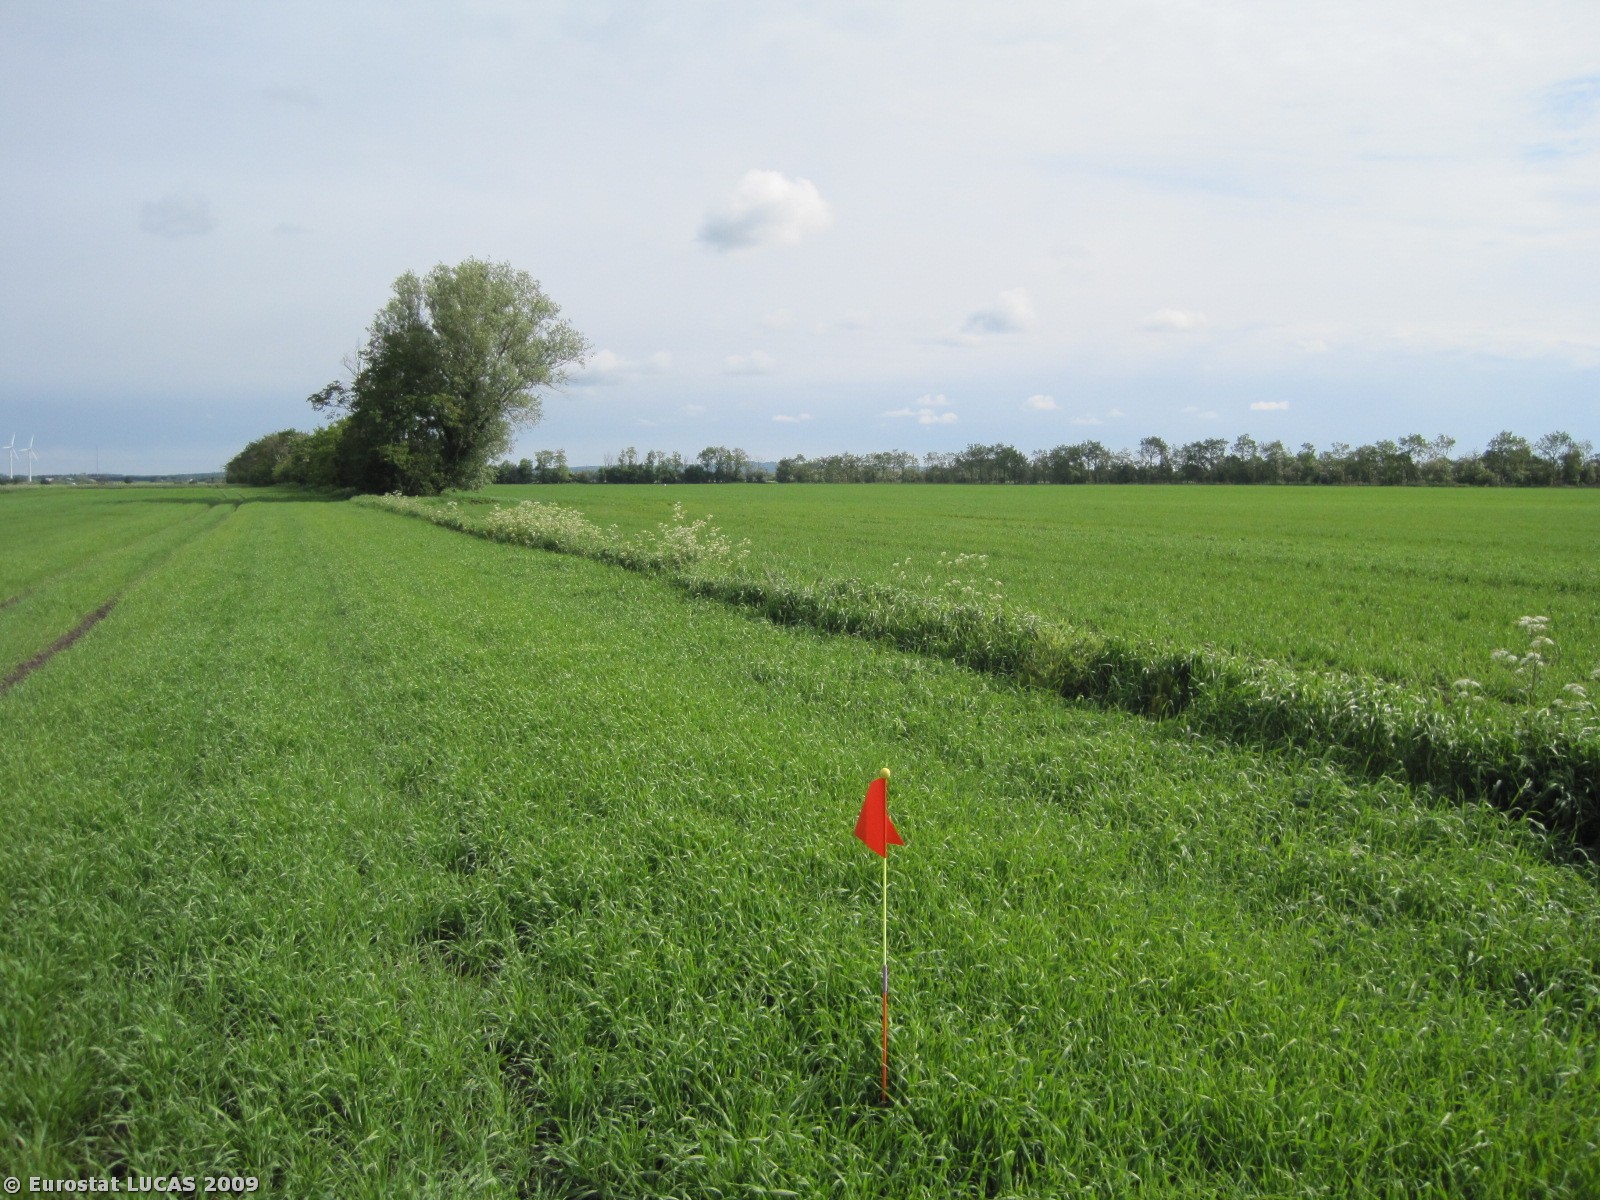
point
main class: Cropland
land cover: Barley
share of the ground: > 75 %
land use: Agriculture (excluding fallow land and kitchen gardens)
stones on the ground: < 10 %
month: June
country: DK
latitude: 57.1044
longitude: 10.2143
